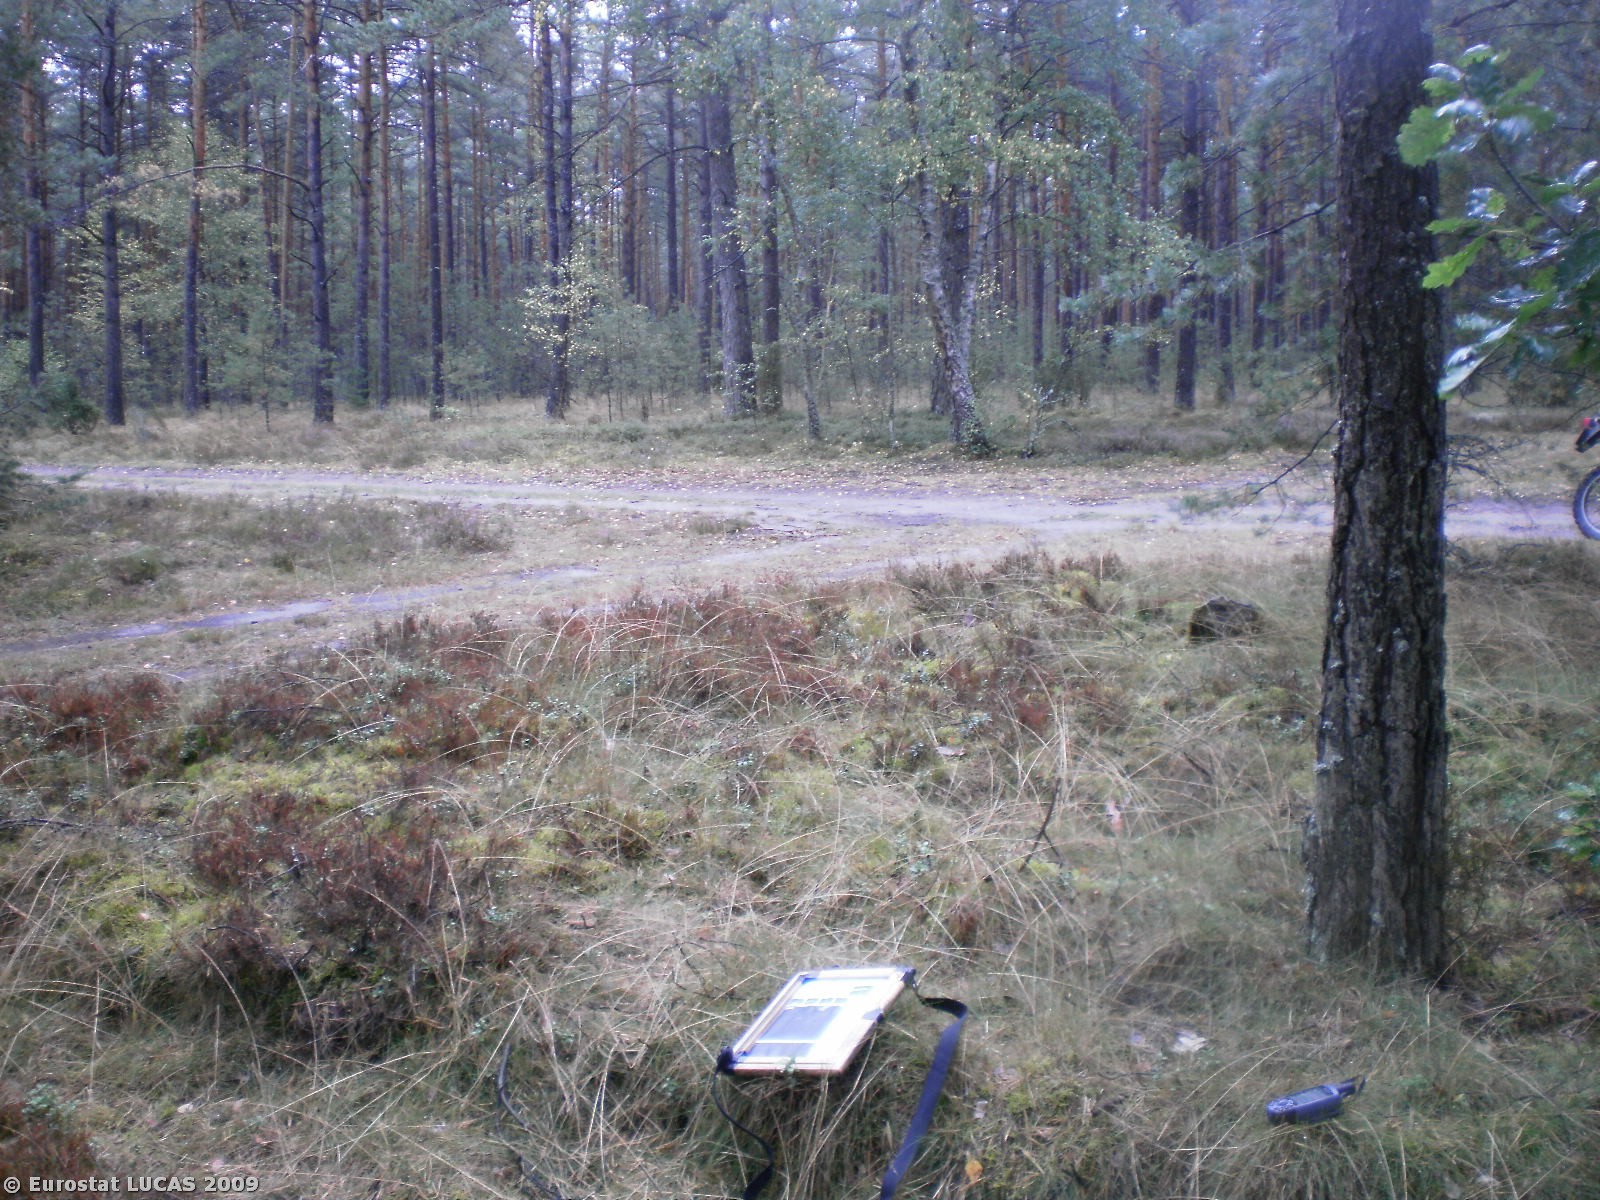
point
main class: Woodland
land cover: Coniferous woodland
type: hemiboreal forest and nemoral coniferous forest and mixed broadleaved-coniferous forest
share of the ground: 50 - 75 %
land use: Forestry
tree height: > 5 m
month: September
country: PL
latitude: 53.8876
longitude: 17.8489
